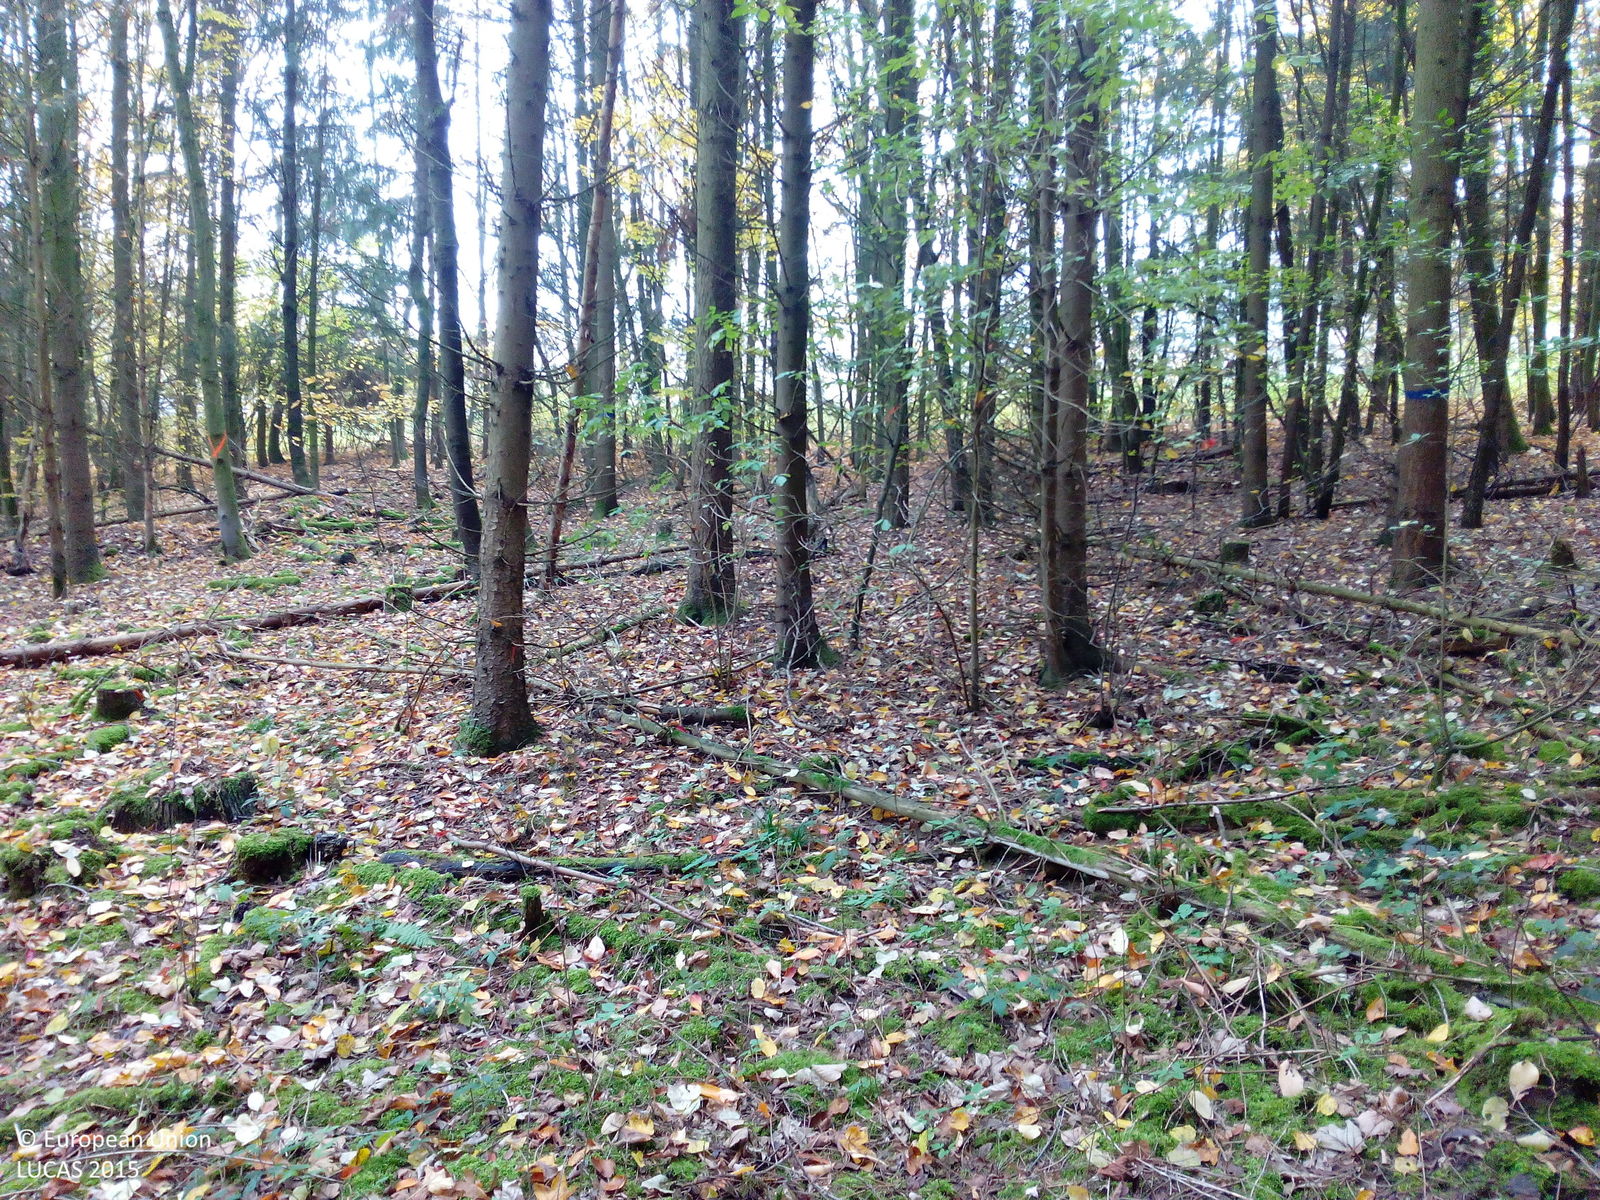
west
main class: Woodland
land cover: Spruce dominated mixed woodland
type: hemiboreal forest and nemoral coniferous forest and mixed broadleaved-coniferous forest
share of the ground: 50 - 75 %
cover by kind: coniferous forest trees 35 %, broadleaved forest trees 25 %, unconsolidated bare surface 20 %, lichens and mosses 15 %, shrubs 5 %
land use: Forestry
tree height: > 5 m
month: October
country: DE
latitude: 50.1662
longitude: 9.9580
